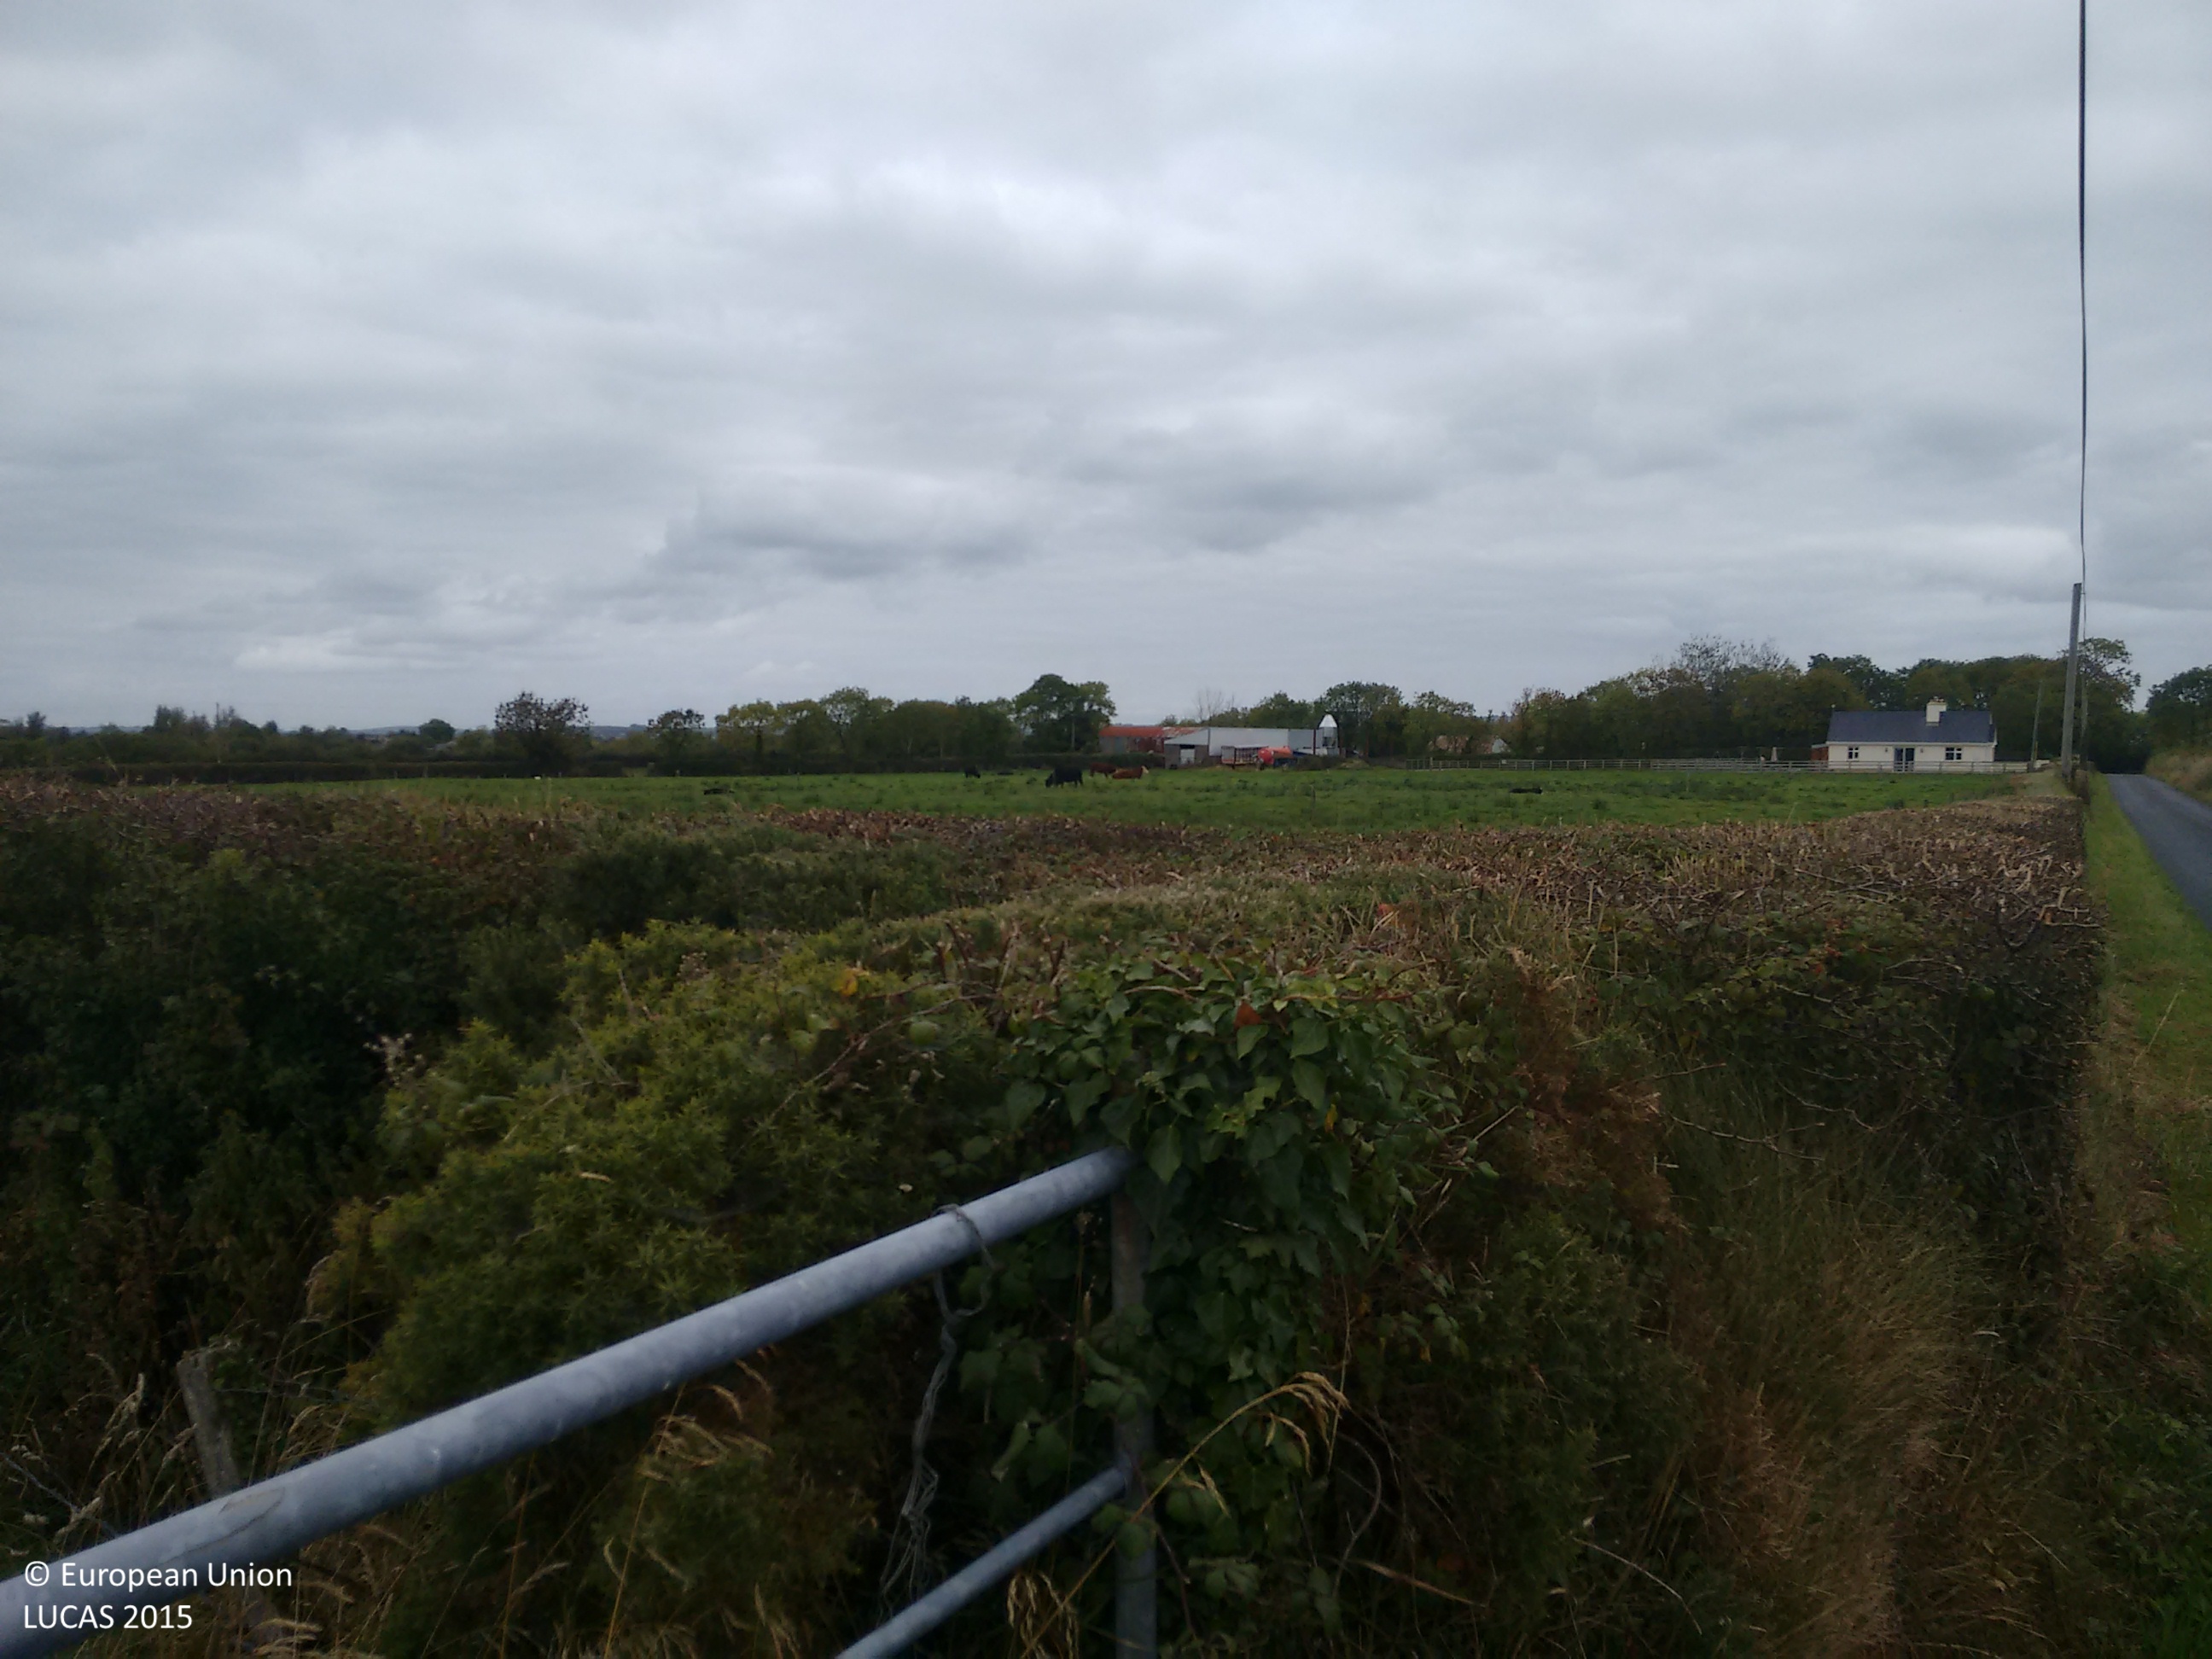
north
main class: Grassland
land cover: Grassland without tree/shrub cover
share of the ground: > 75 %
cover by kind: herbaceous plants 100 %
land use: Agriculture (excluding fallow land and kitchen gardens)
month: September
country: IE
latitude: 52.3678
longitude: -8.9361
